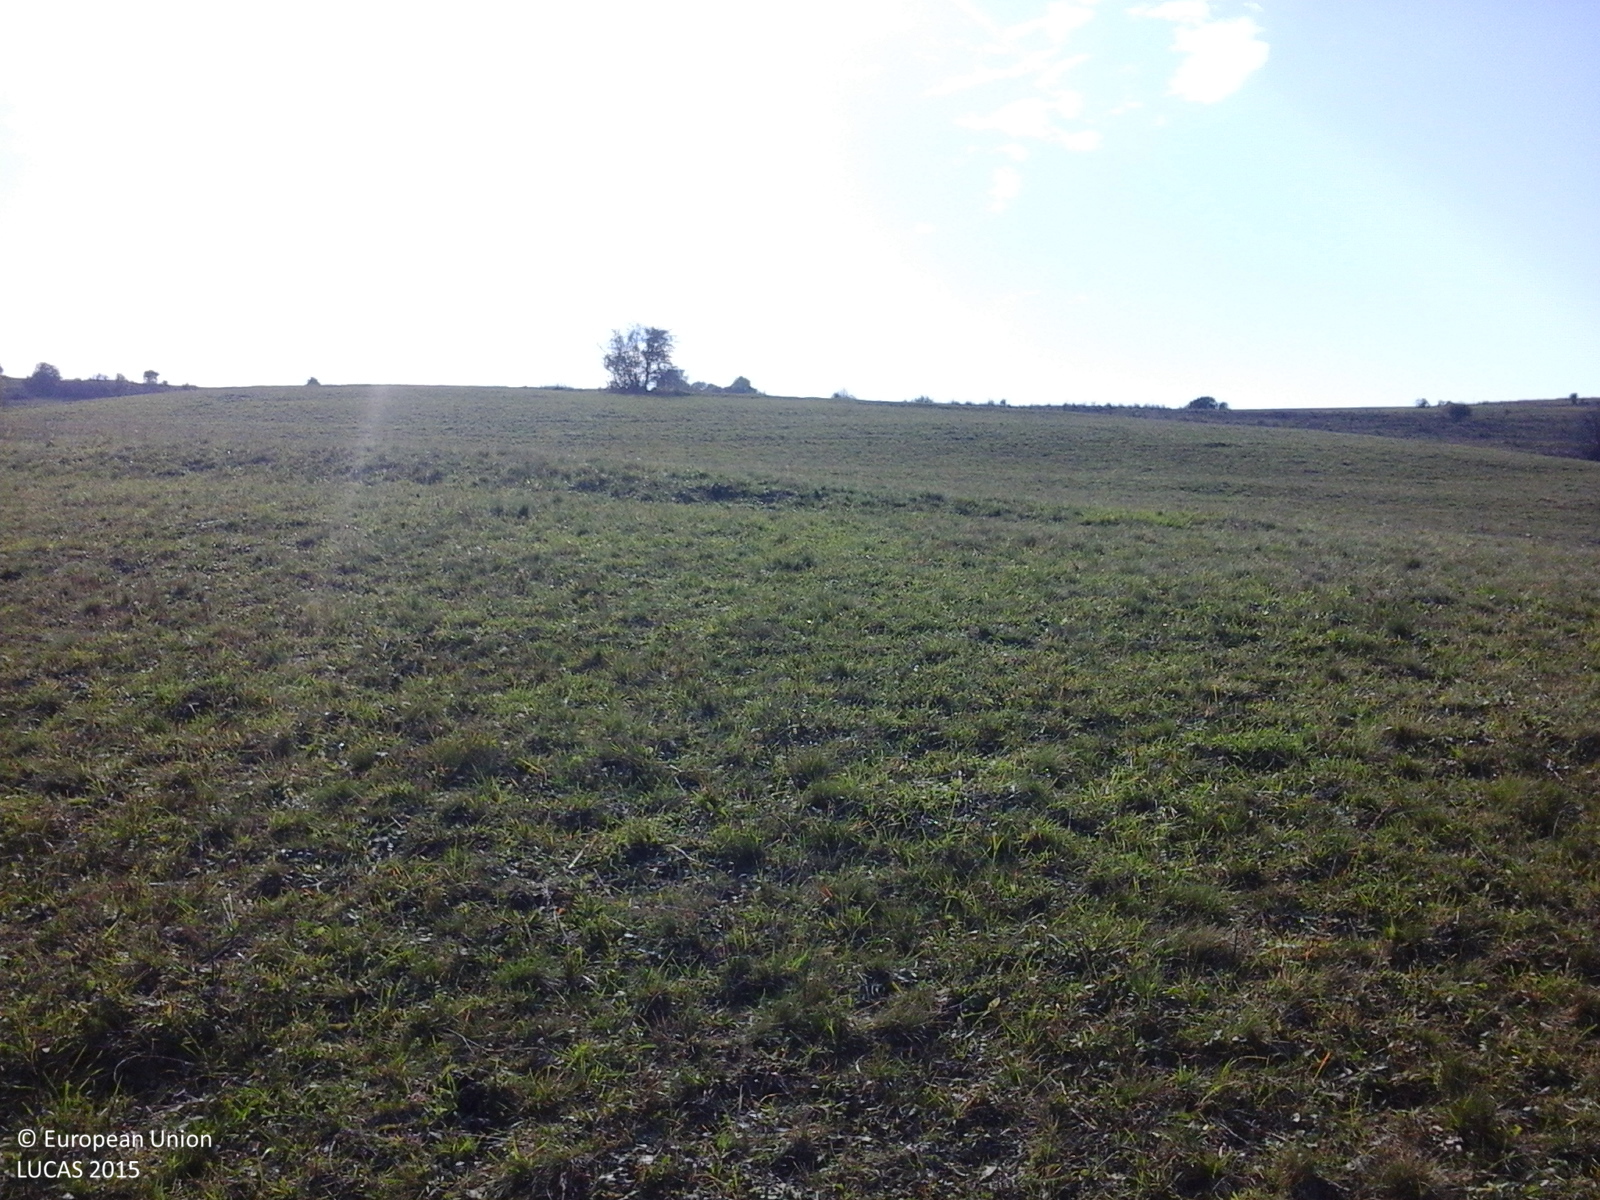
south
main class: Grassland
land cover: Grassland without tree/shrub cover
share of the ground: > 75 %
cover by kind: herbaceous plants 100 %
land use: Agriculture (excluding fallow land and kitchen gardens)
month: October
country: RO
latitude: 46.4672
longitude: 25.0613
